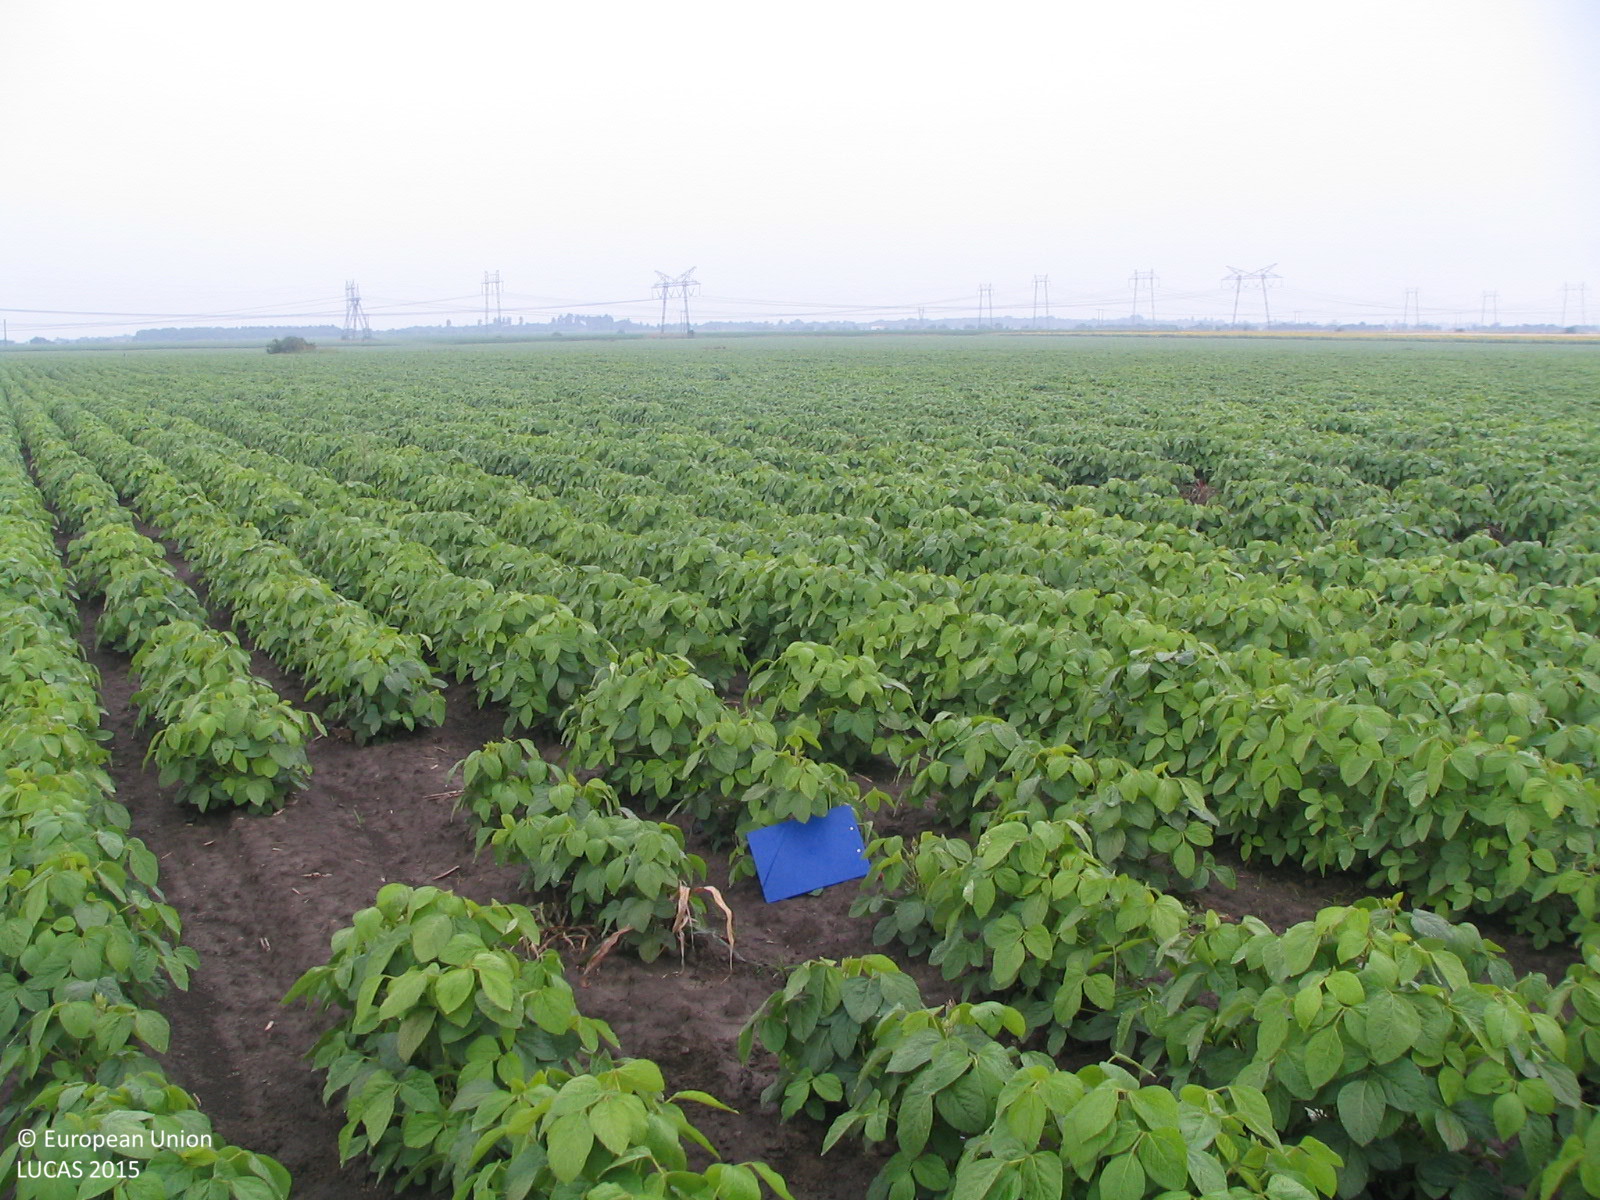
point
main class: Cropland
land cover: Dry pulses
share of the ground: 50 - 75 %
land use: Agriculture (excluding fallow land and kitchen gardens)
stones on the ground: < 10 %
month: June
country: BG
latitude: 43.4714
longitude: 23.9838
